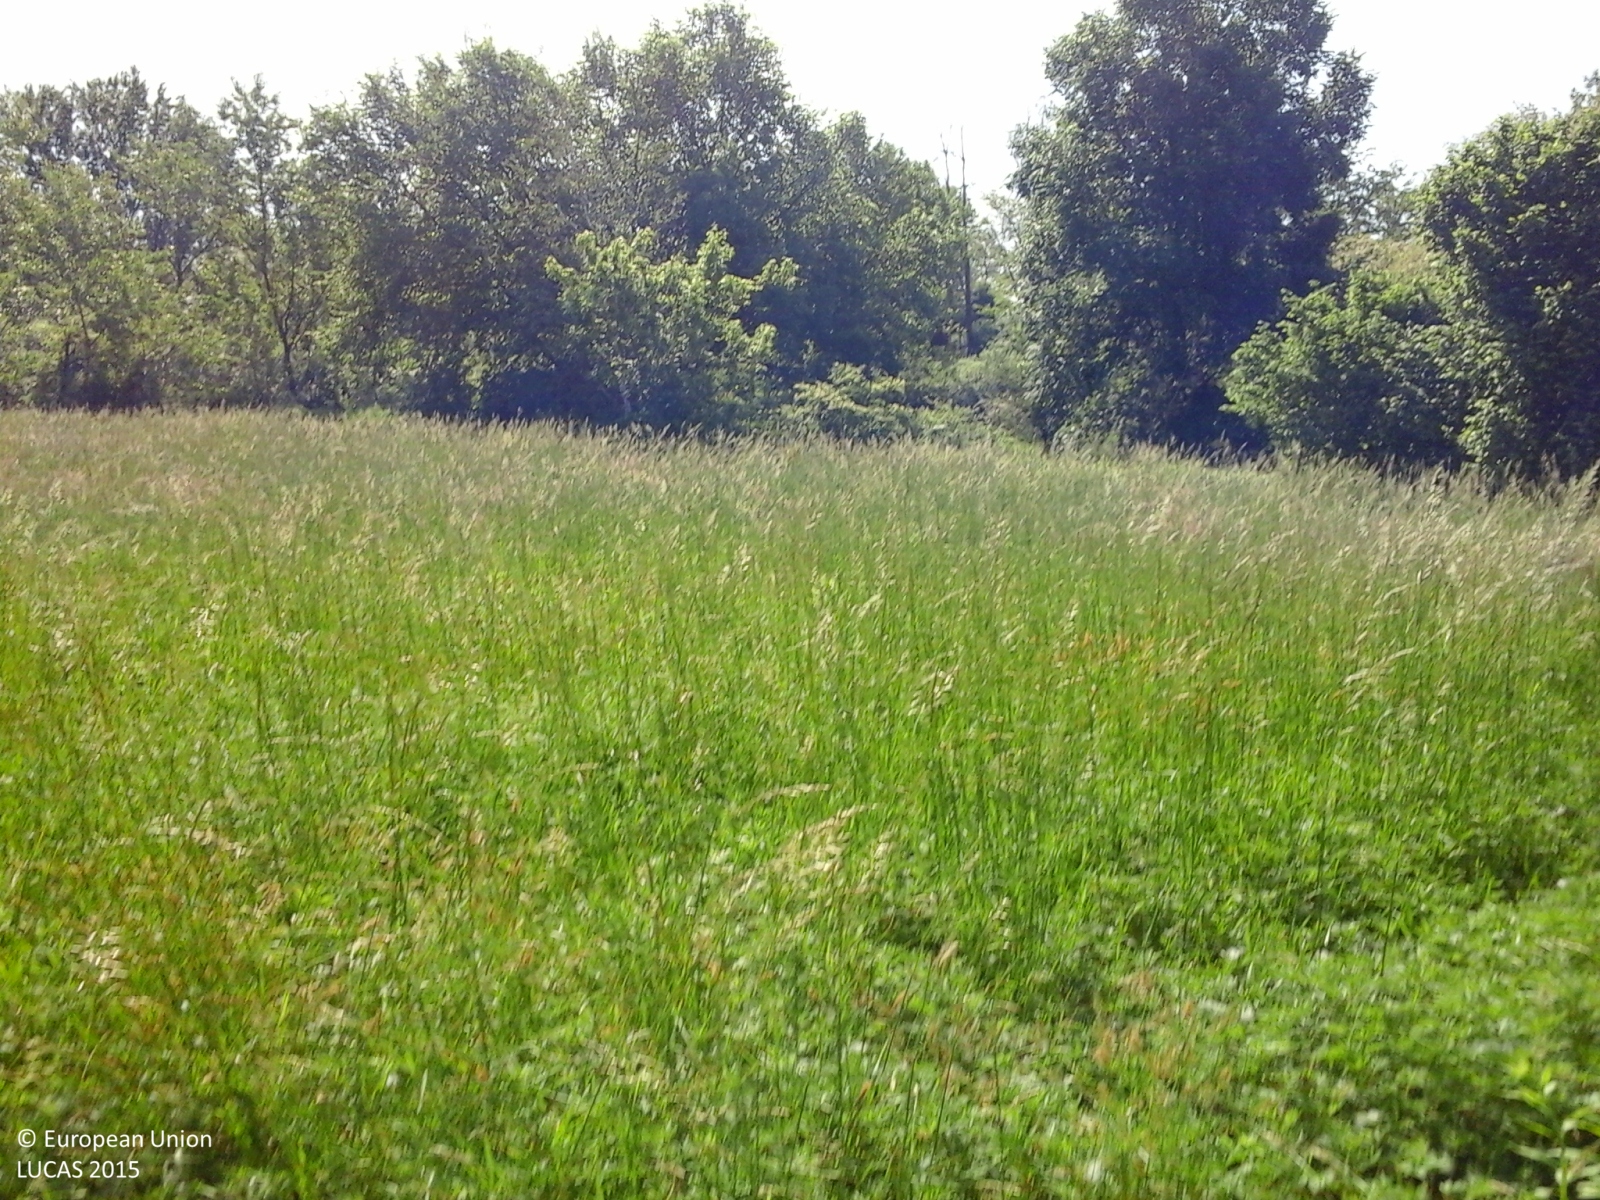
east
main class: Shrubland
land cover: Shrubland with sparse tree cover
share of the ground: > 75 %
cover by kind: shrubs 80 %, herbaceous plants 15 %, broadleaved forest trees 5 %
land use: Fallow land
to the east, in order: Shrubland with sparse tree cover; Grassland without tree/shrub cover; Paved roads, cycling and walking lanes; Broadleaved woodland; Grassland with sparse tree/shrub cover; Paved roads, cycling and walking lanes; Shrubland with sparse tree cover; Paved roads, cycling and walking lanes; Grassland with sparse tree/shrub cover
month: May
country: IT
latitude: 45.5726
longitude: 9.0917
